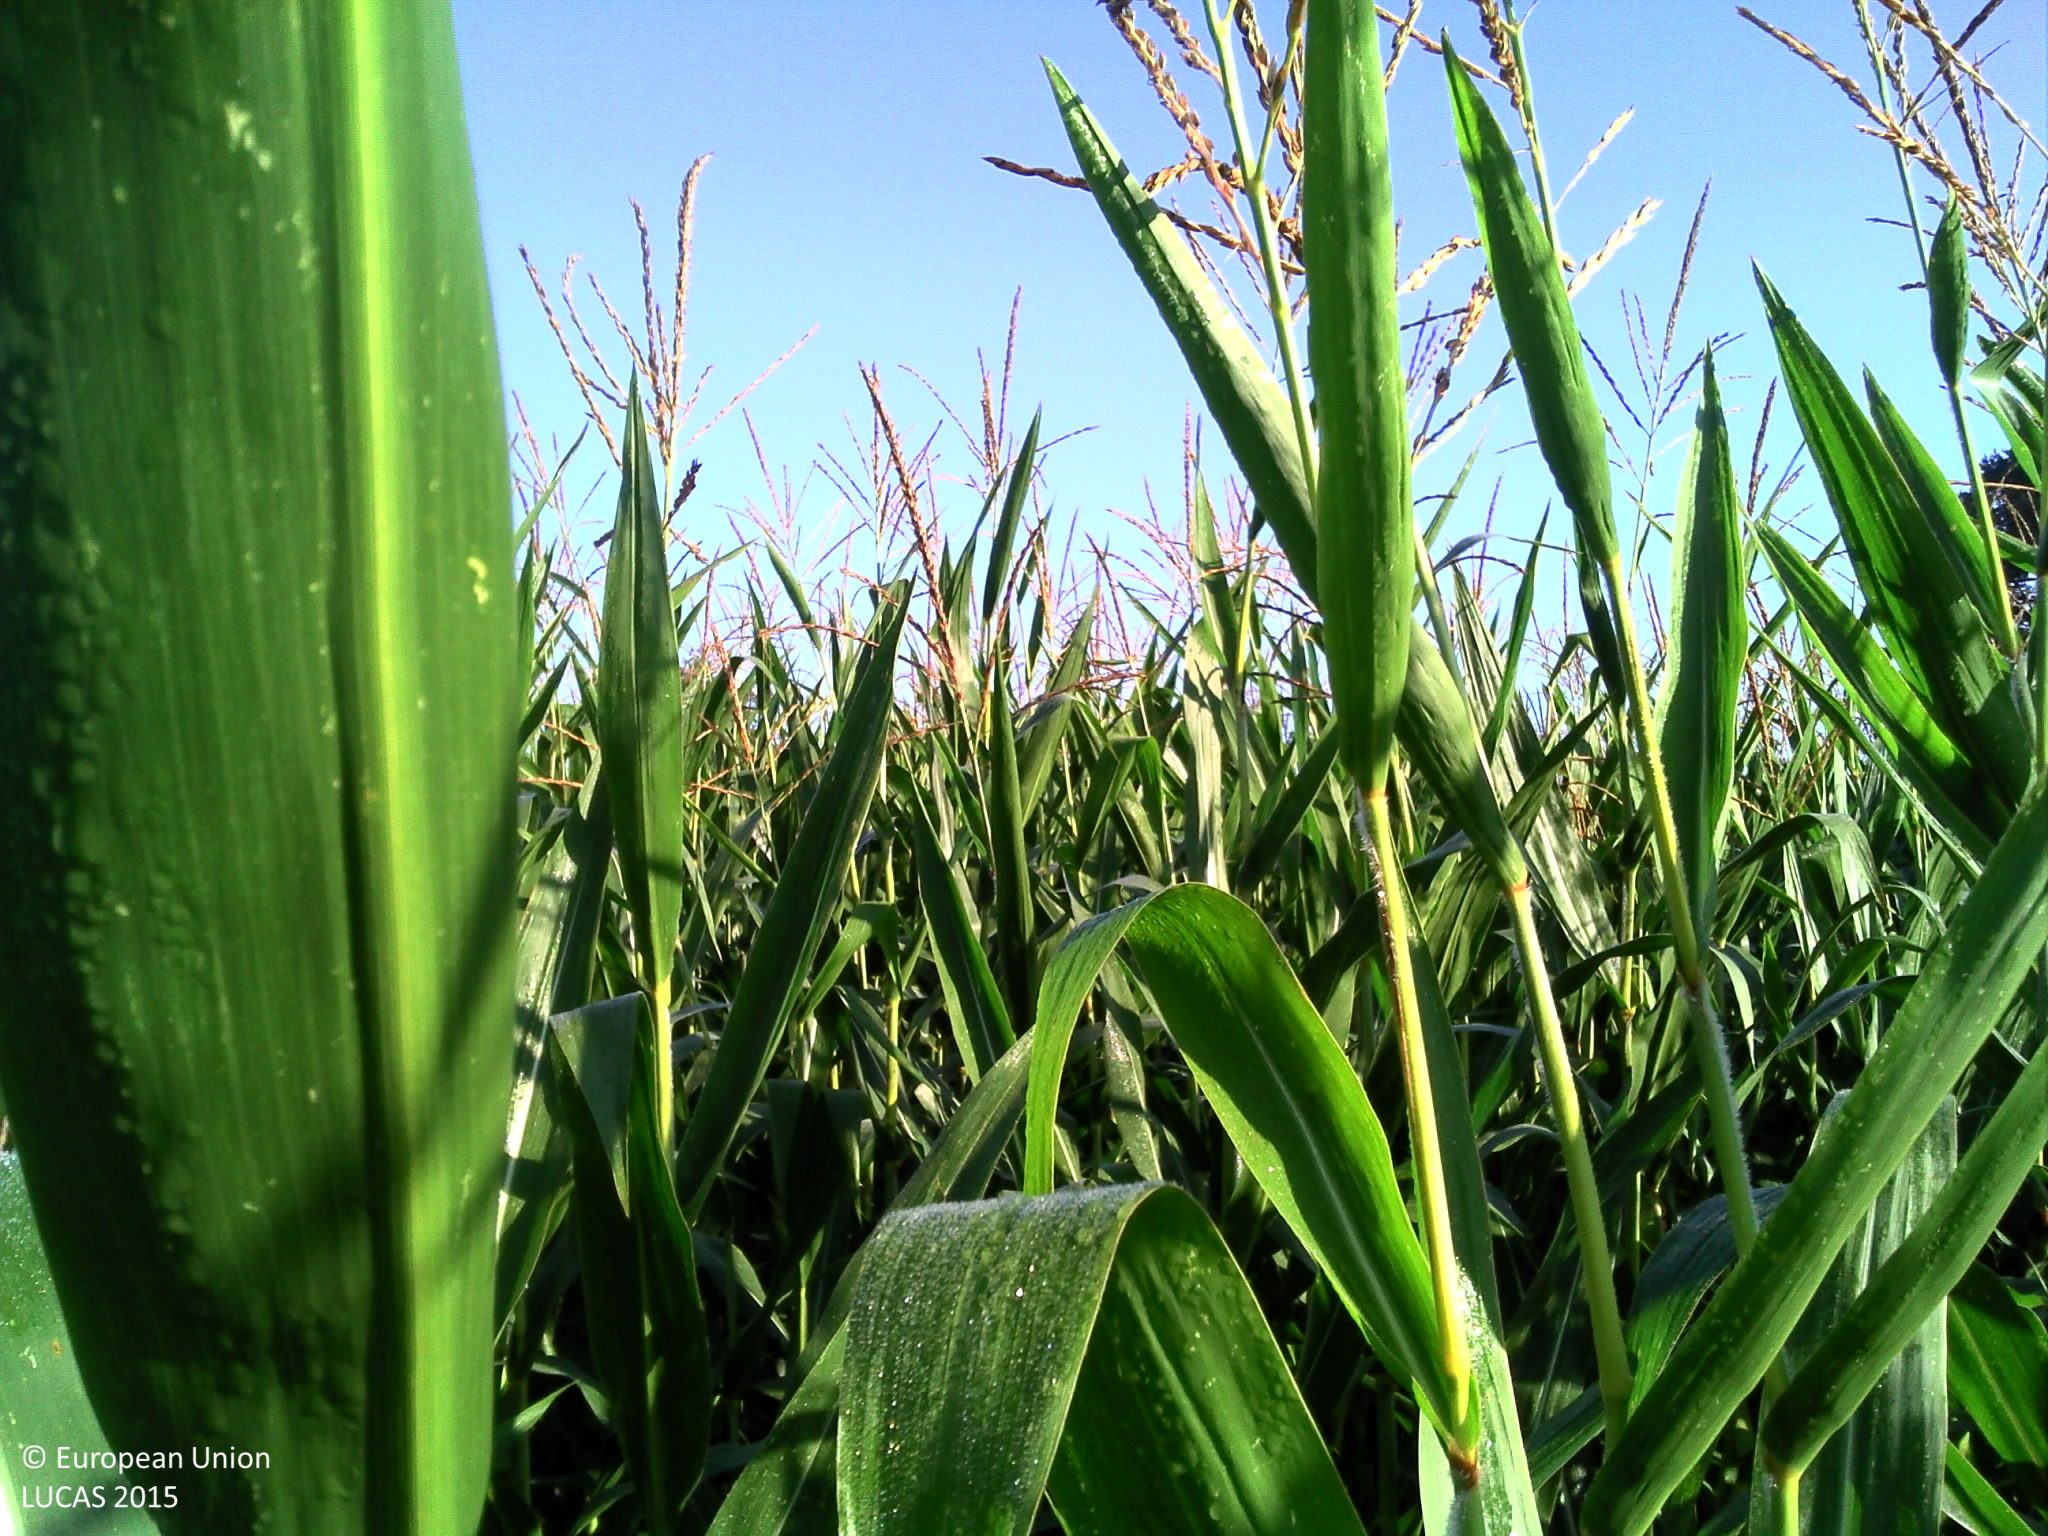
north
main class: Cropland
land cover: Maize
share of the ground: > 75 %
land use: Agriculture (excluding fallow land and kitchen gardens)
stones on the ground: 10 - 25 %
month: September
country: FR
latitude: 43.5242
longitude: -0.6884
